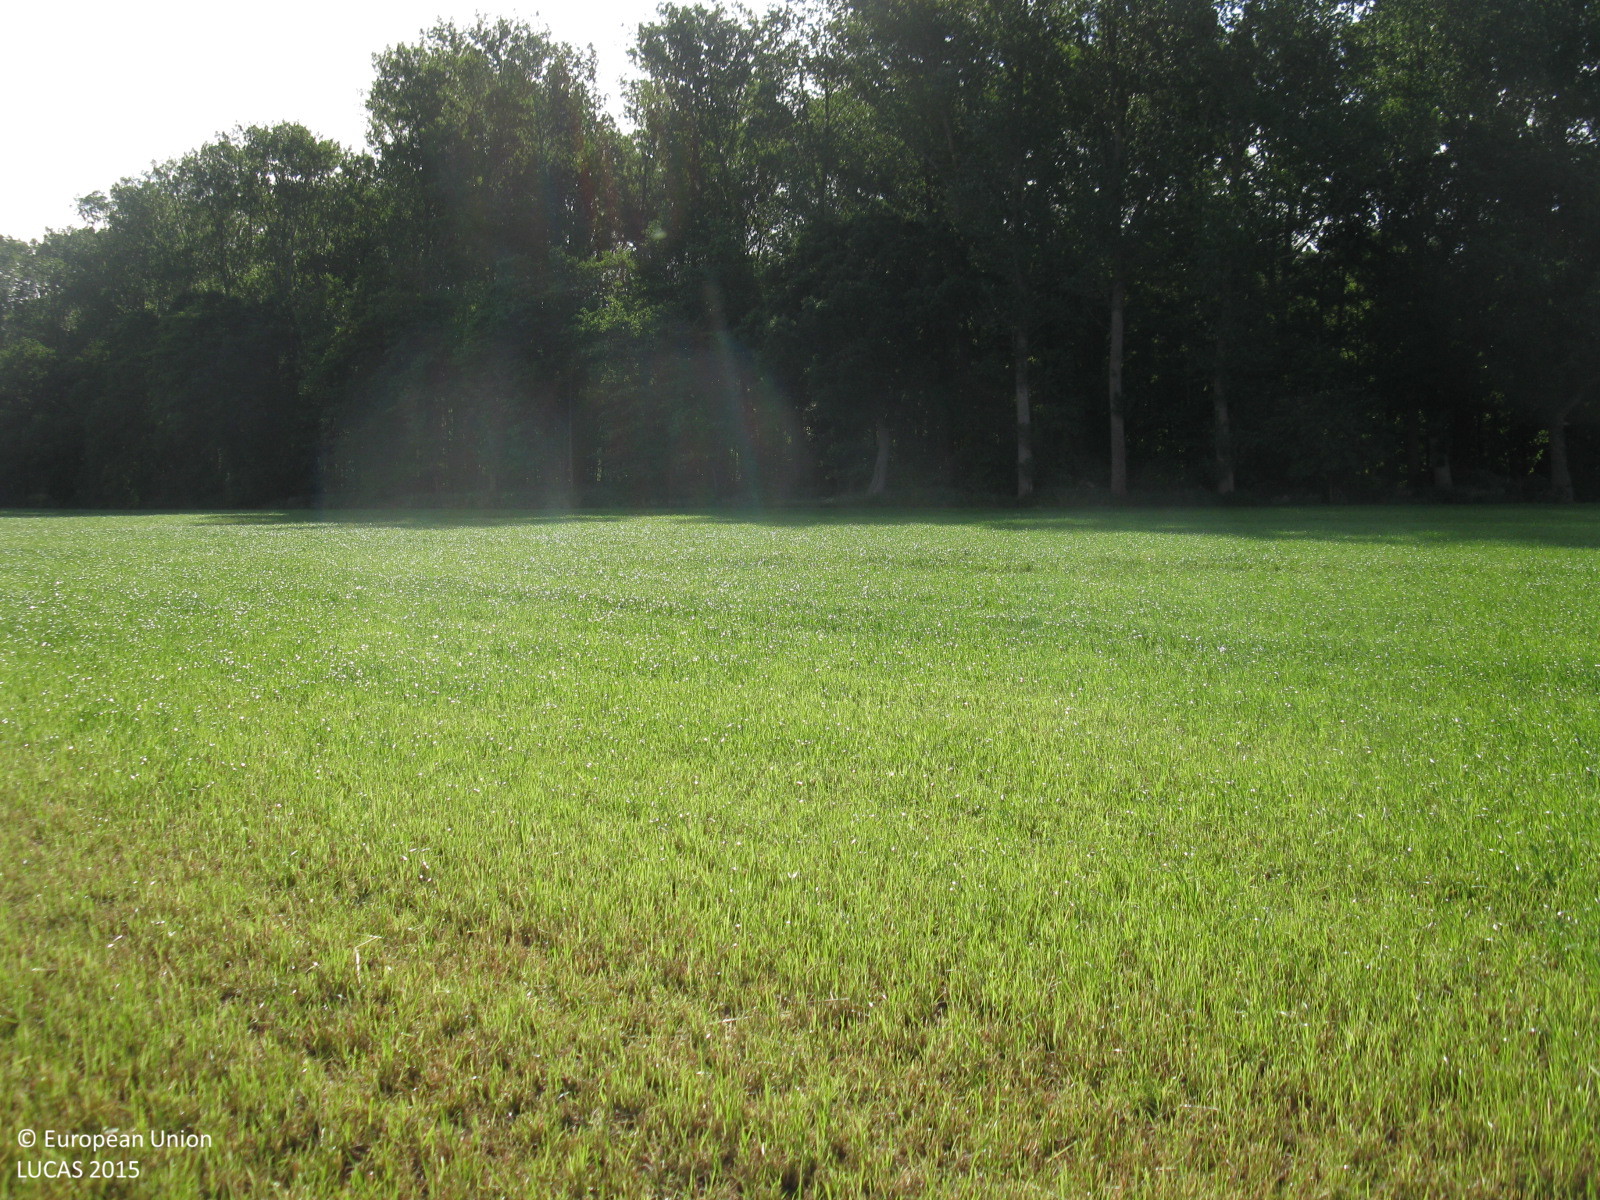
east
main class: Grassland
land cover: Grassland without tree/shrub cover
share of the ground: > 75 %
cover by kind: herbaceous plants 100 %
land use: Agriculture (excluding fallow land and kitchen gardens)
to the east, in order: Grassland without tree/shrub cover; Broadleaved woodland; Inland fresh running water; Broadleaved woodland
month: July
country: DE
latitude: 53.4029
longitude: 7.9701
